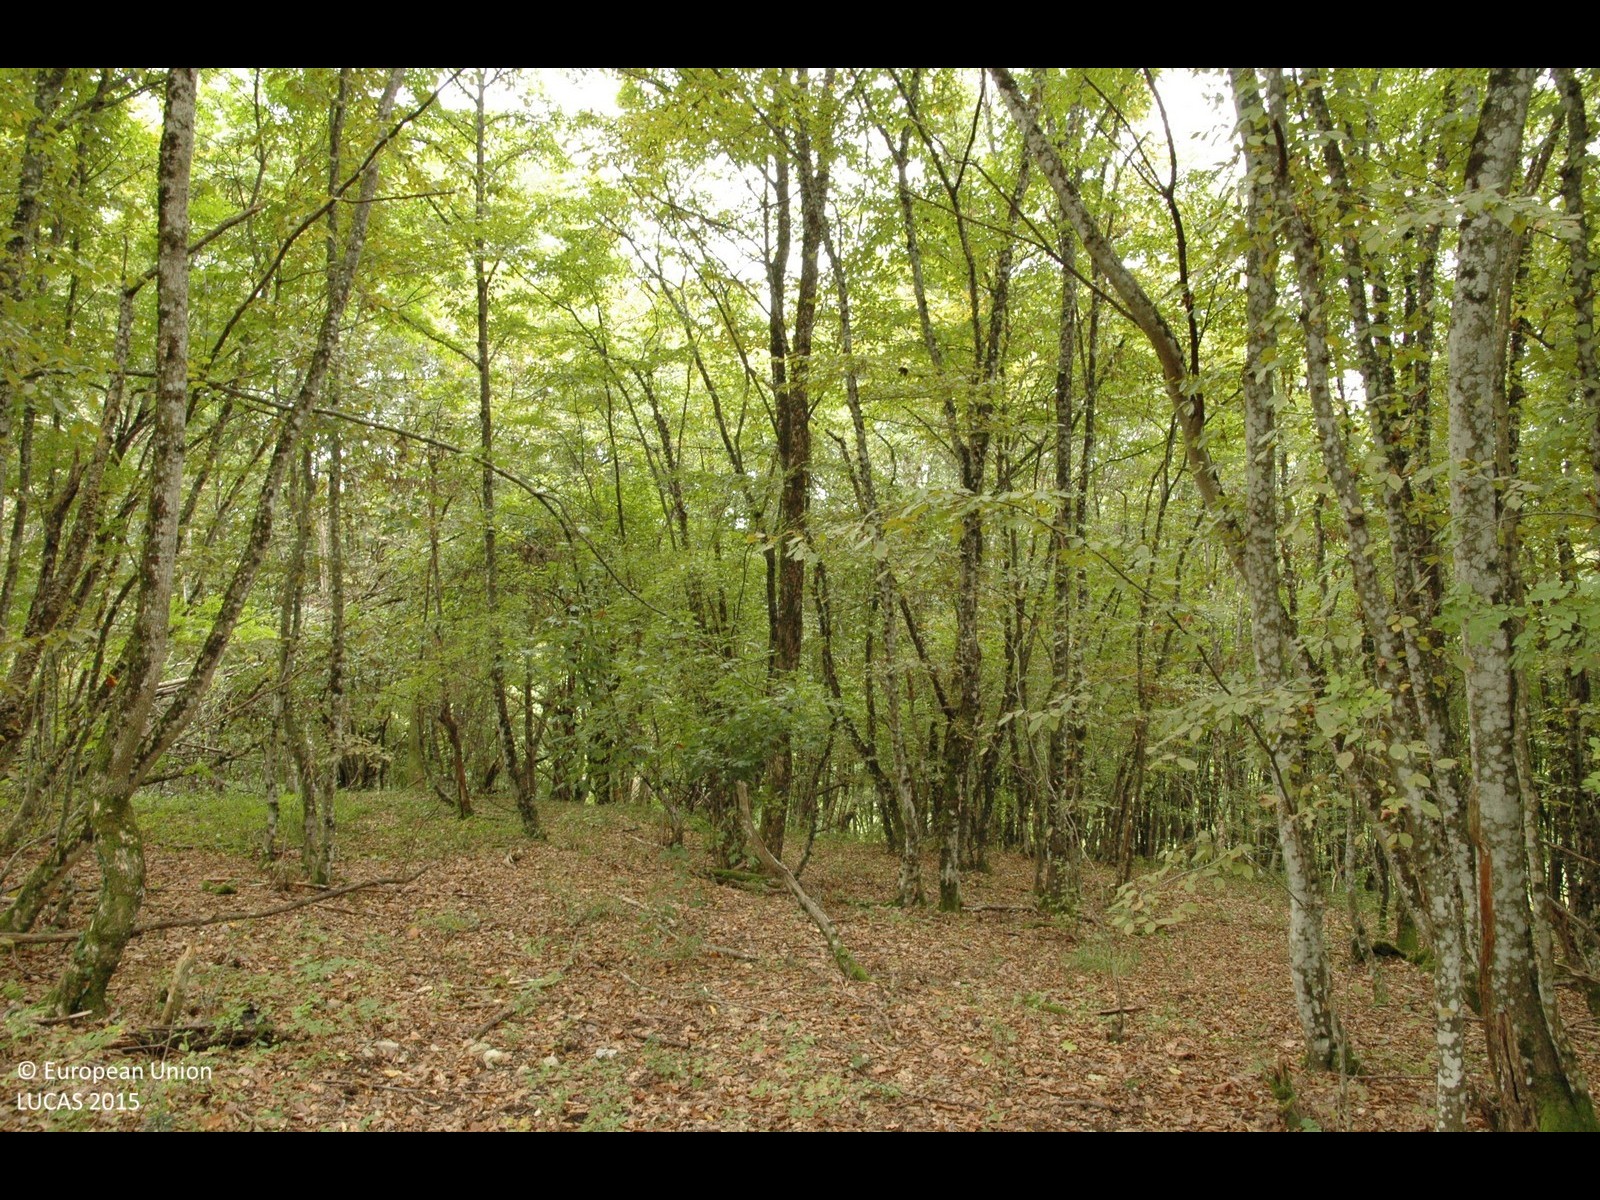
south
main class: Woodland
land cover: Broadleaved woodland
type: mesophytic deciduous forest
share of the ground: > 75 %
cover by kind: broadleaved forest trees 100 %
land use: Forestry
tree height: > 5 m
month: September
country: HR
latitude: 45.2646
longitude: 15.6161
